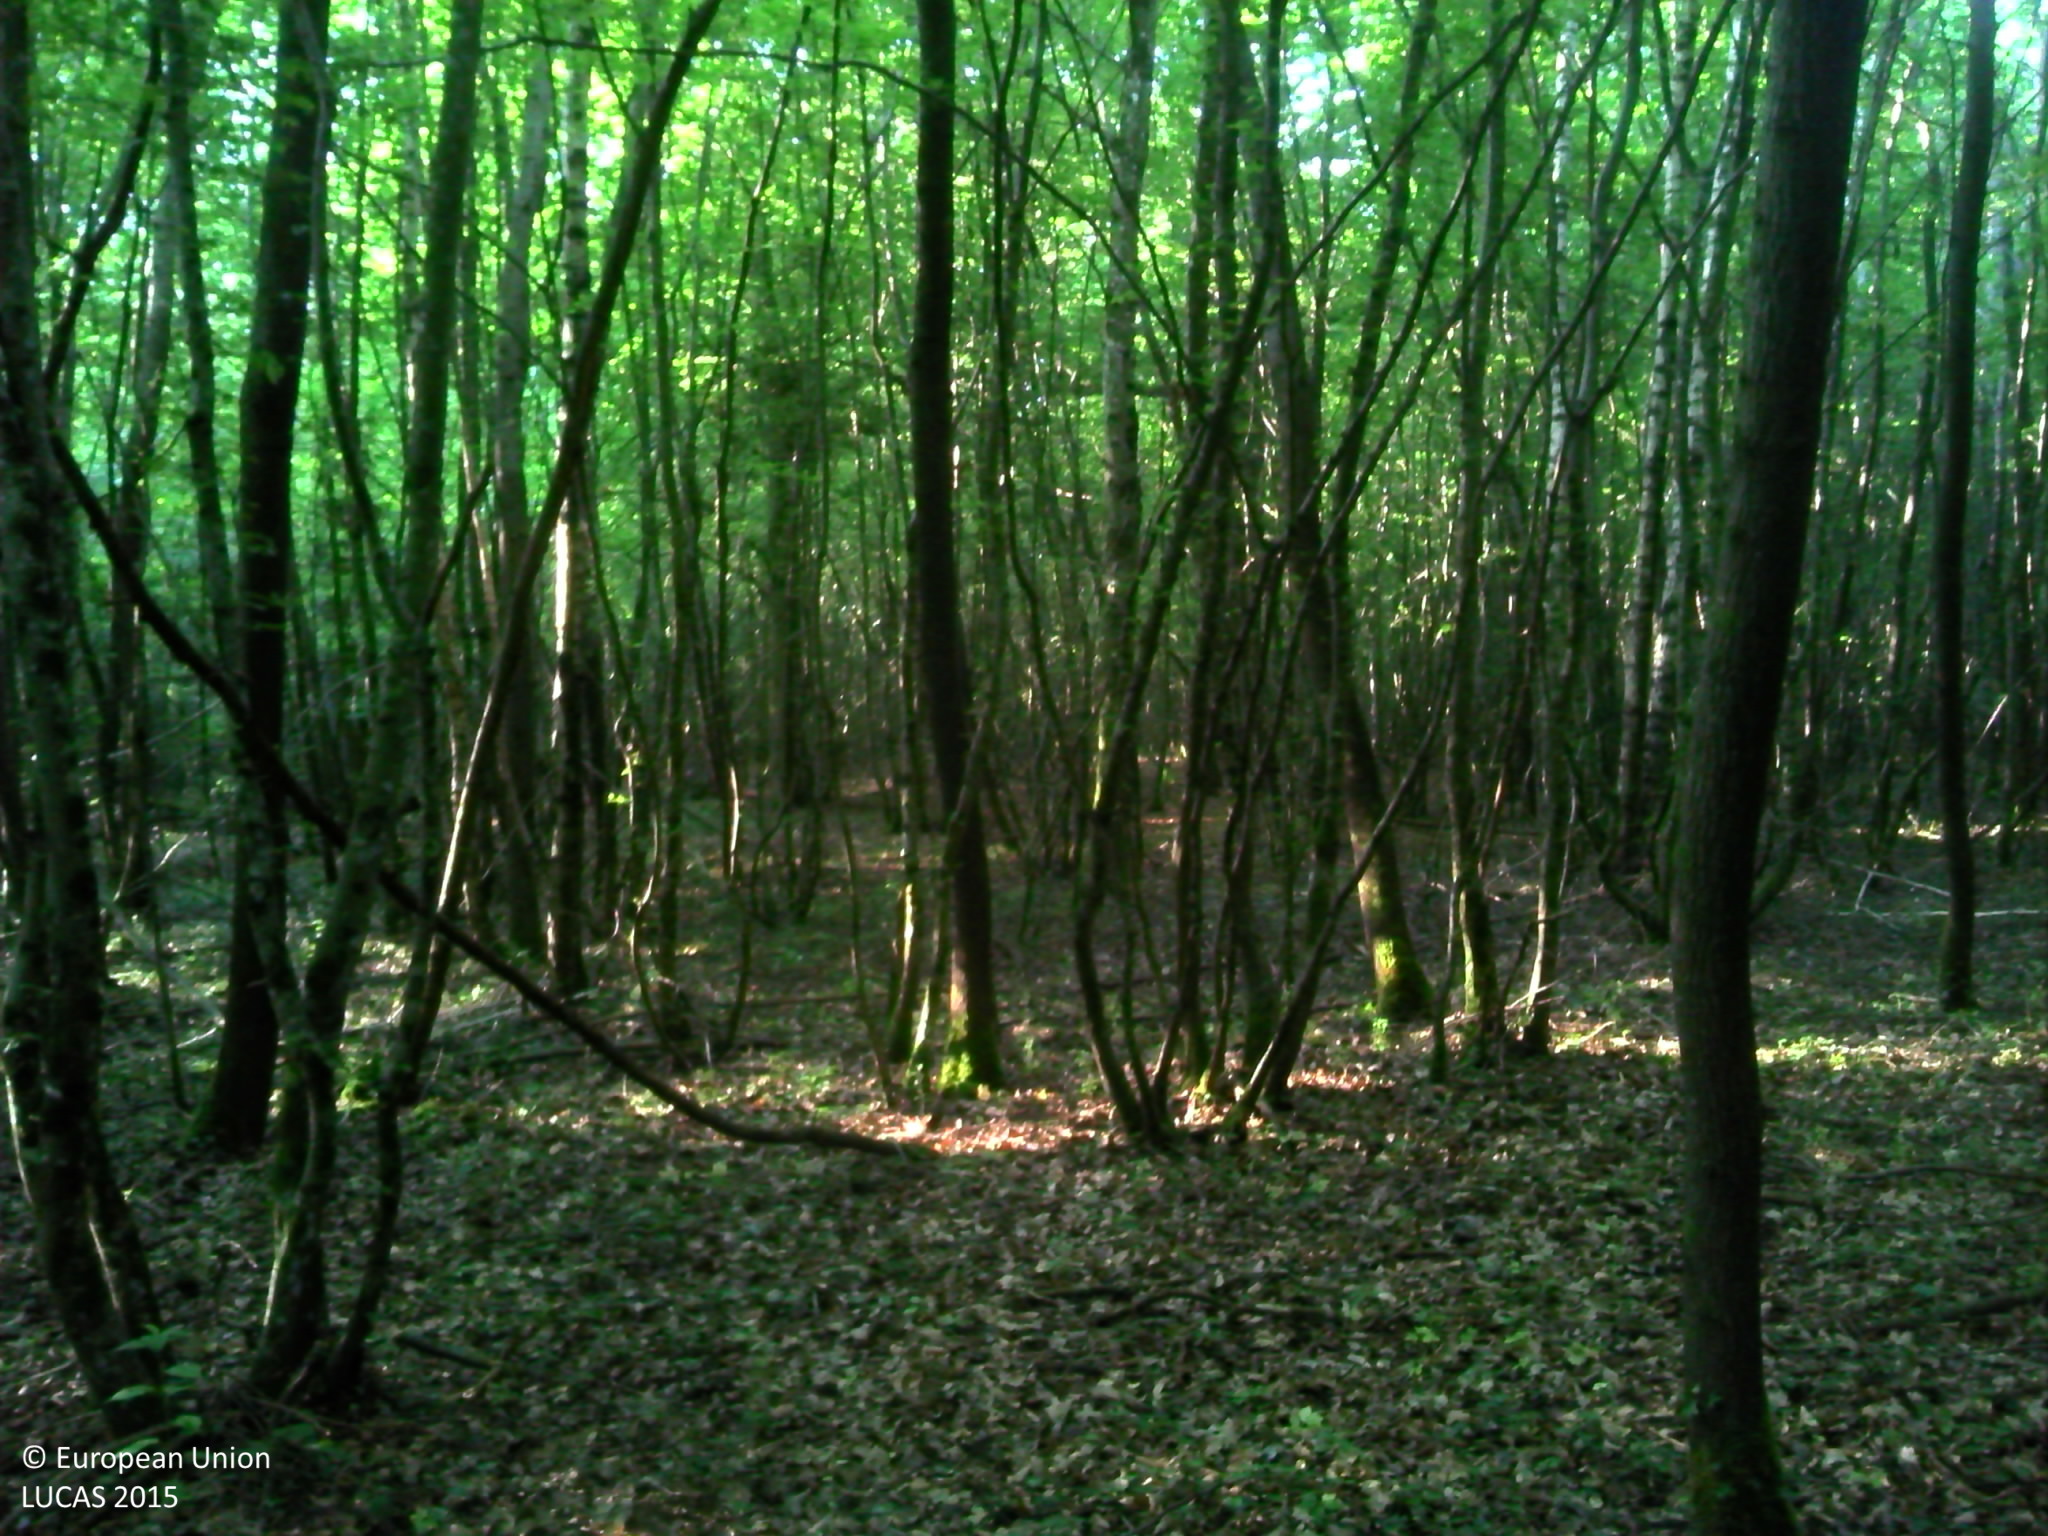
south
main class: Woodland
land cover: Broadleaved woodland
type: acidophilous oak and oak-birch forest
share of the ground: > 75 %
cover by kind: broadleaved forest trees 95 %, herbaceous plants 5 %
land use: Forestry
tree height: > 5 m
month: June
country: FR
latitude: 46.7026
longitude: 5.3853
